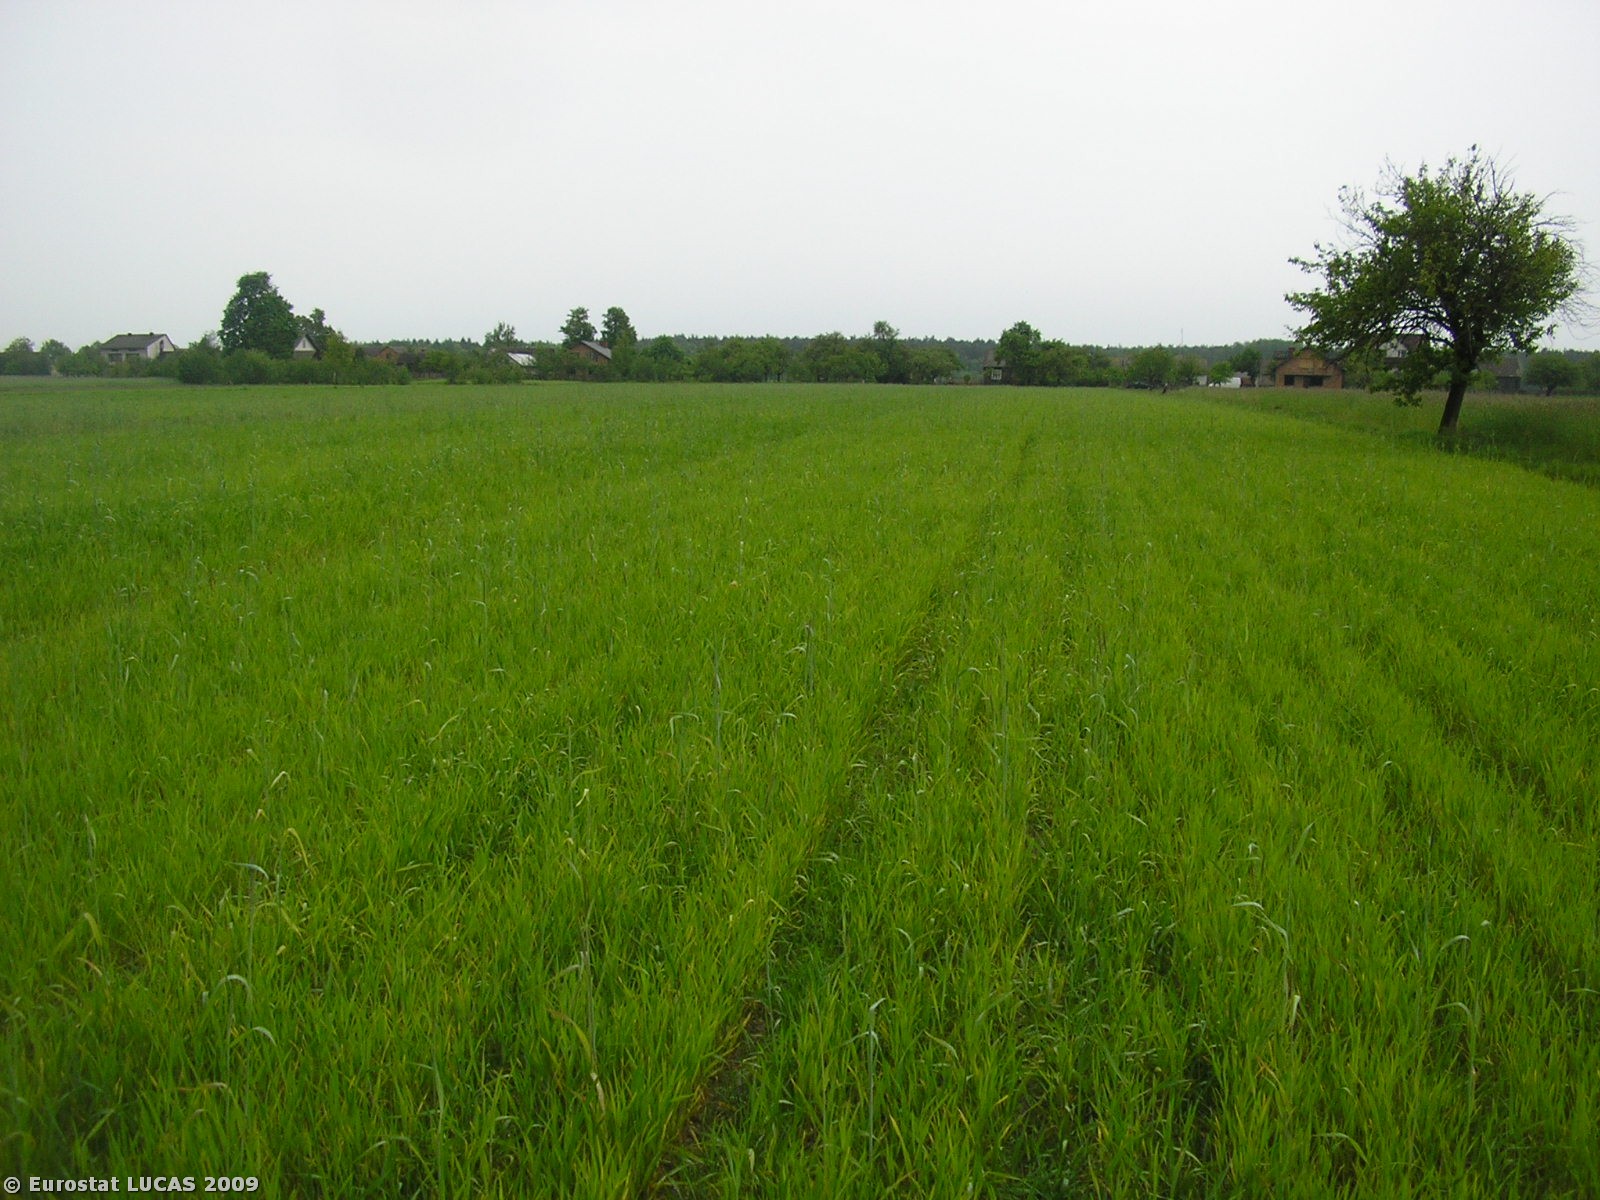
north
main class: Cropland
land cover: Triticale
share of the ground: 50 - 75 %
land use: Agriculture (excluding fallow land and kitchen gardens)
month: May
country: PL
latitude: 51.3754
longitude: 19.9885
